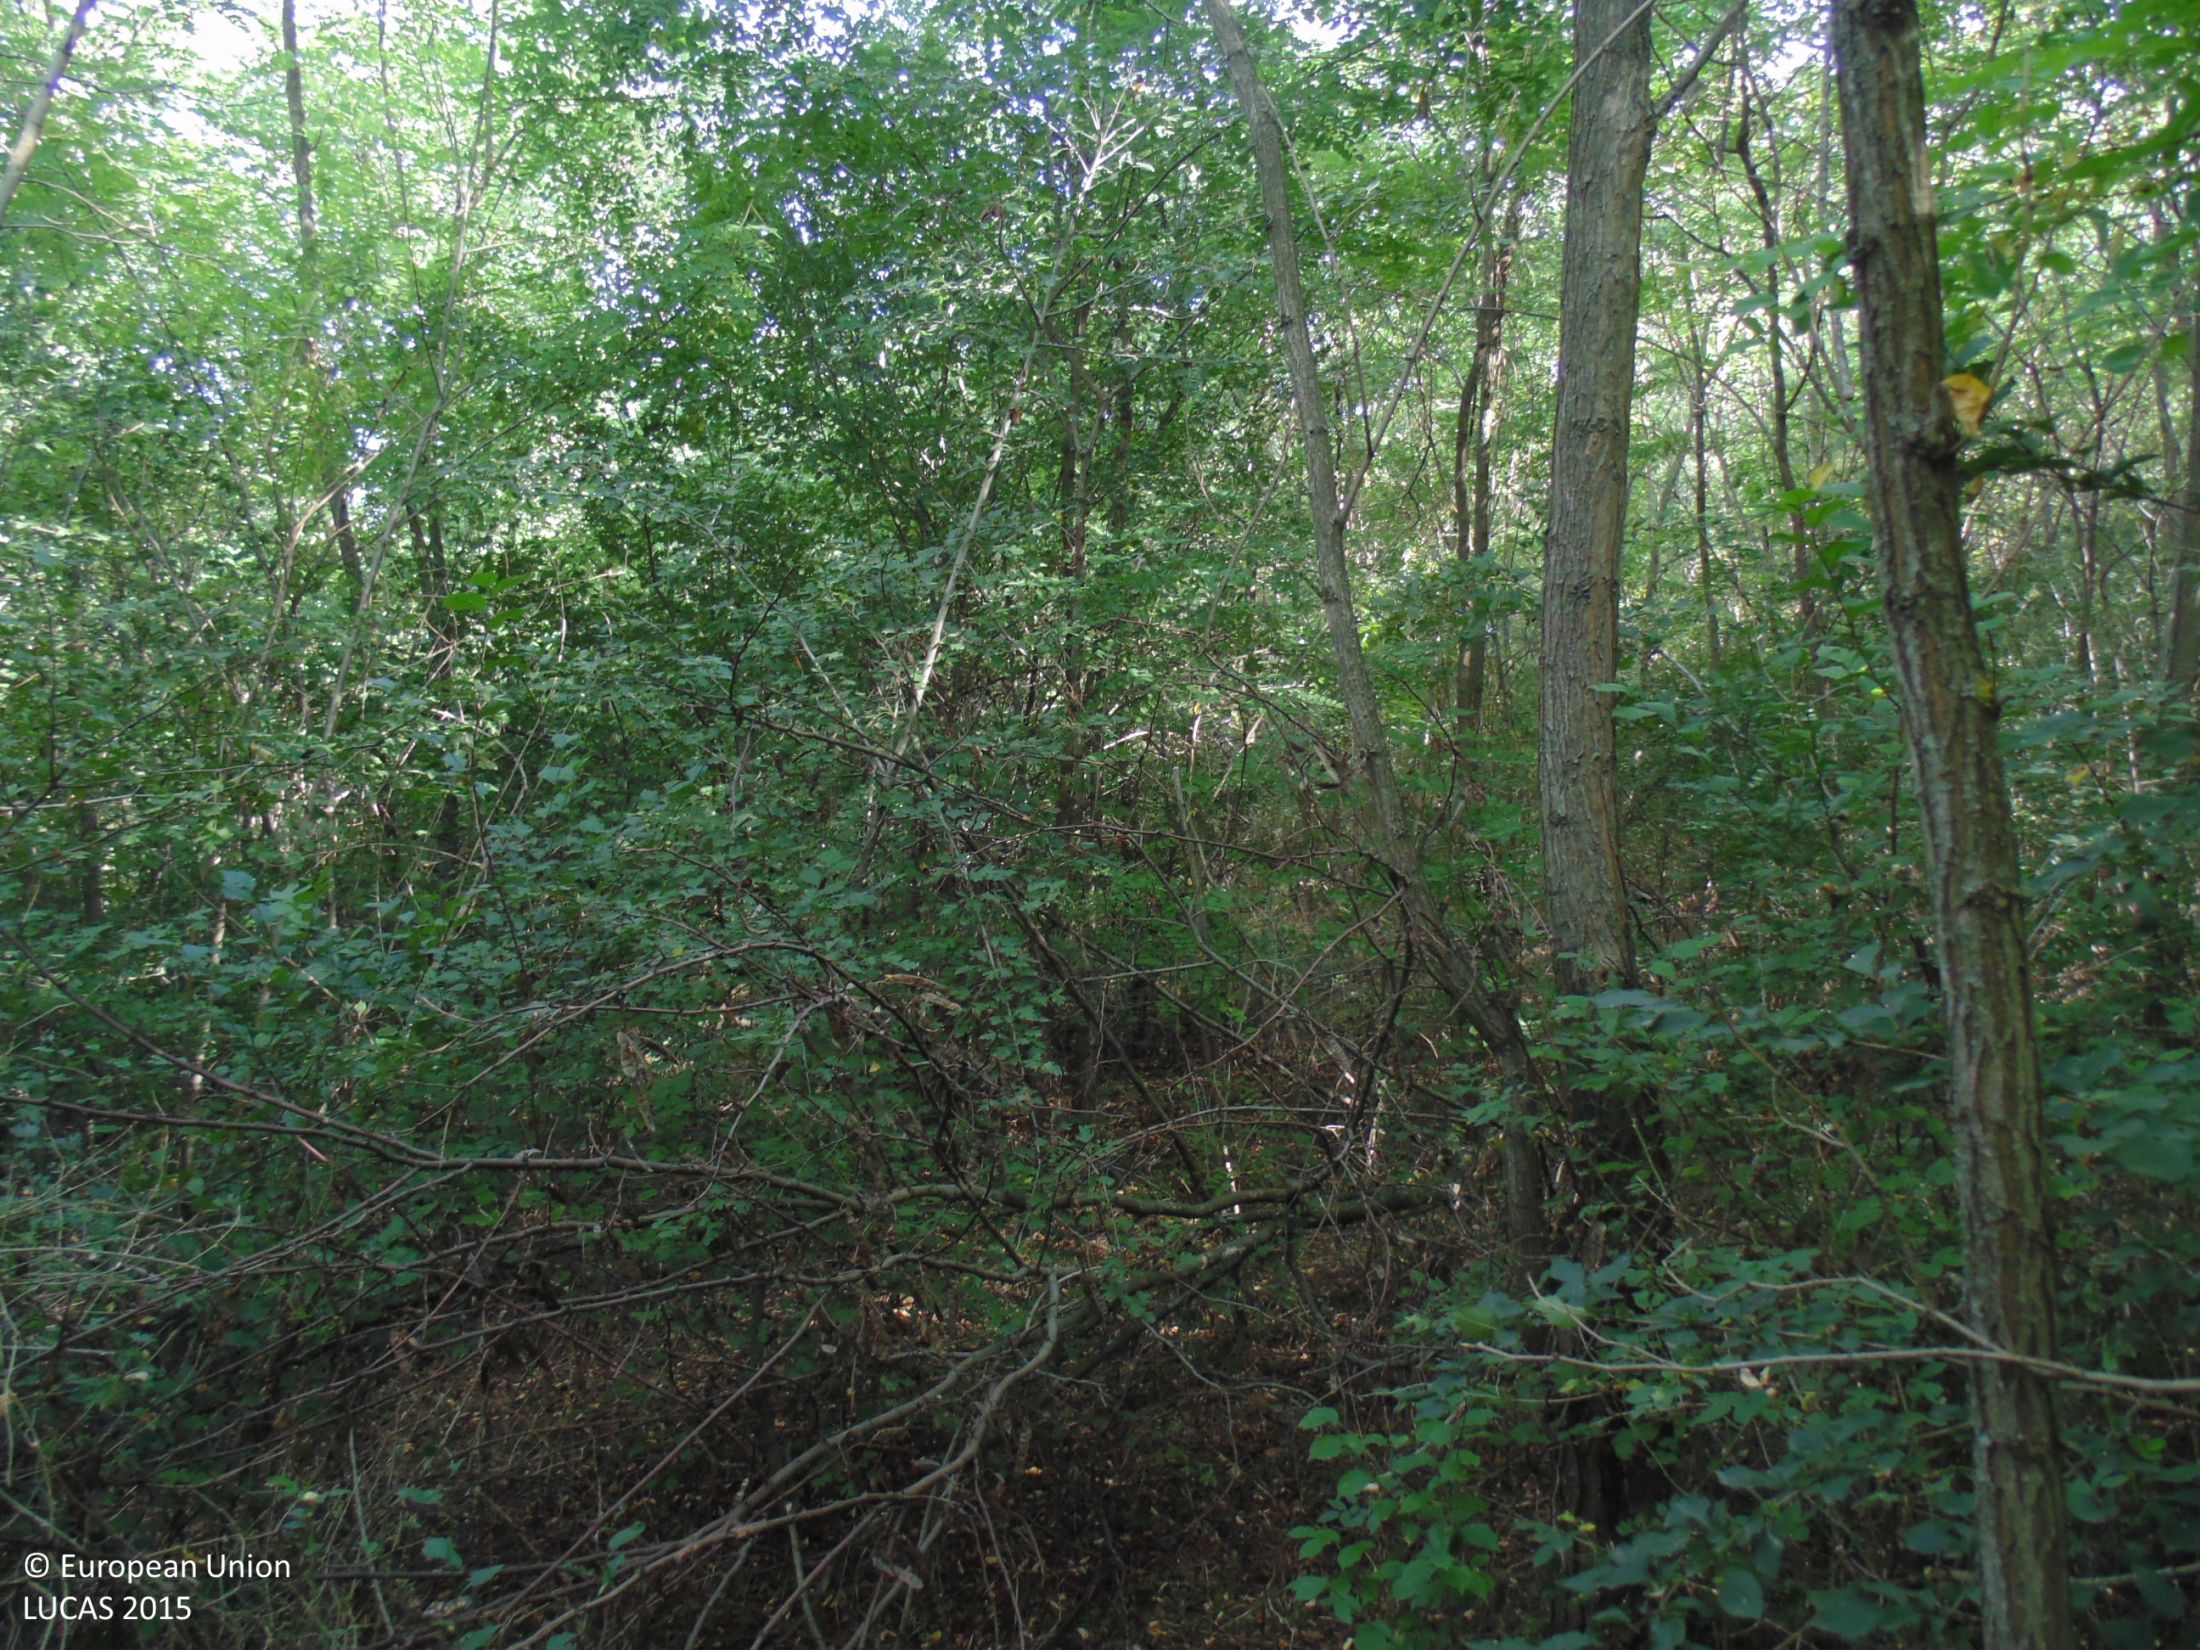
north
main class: Woodland
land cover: Broadleaved woodland
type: mesophytic deciduous forest
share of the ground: > 75 %
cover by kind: broadleaved forest trees 90 %, shrubs 5 %, unconsolidated bare surface 5 %
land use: Forestry
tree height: > 5 m
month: September
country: BG
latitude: 43.8384
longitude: 27.1009
